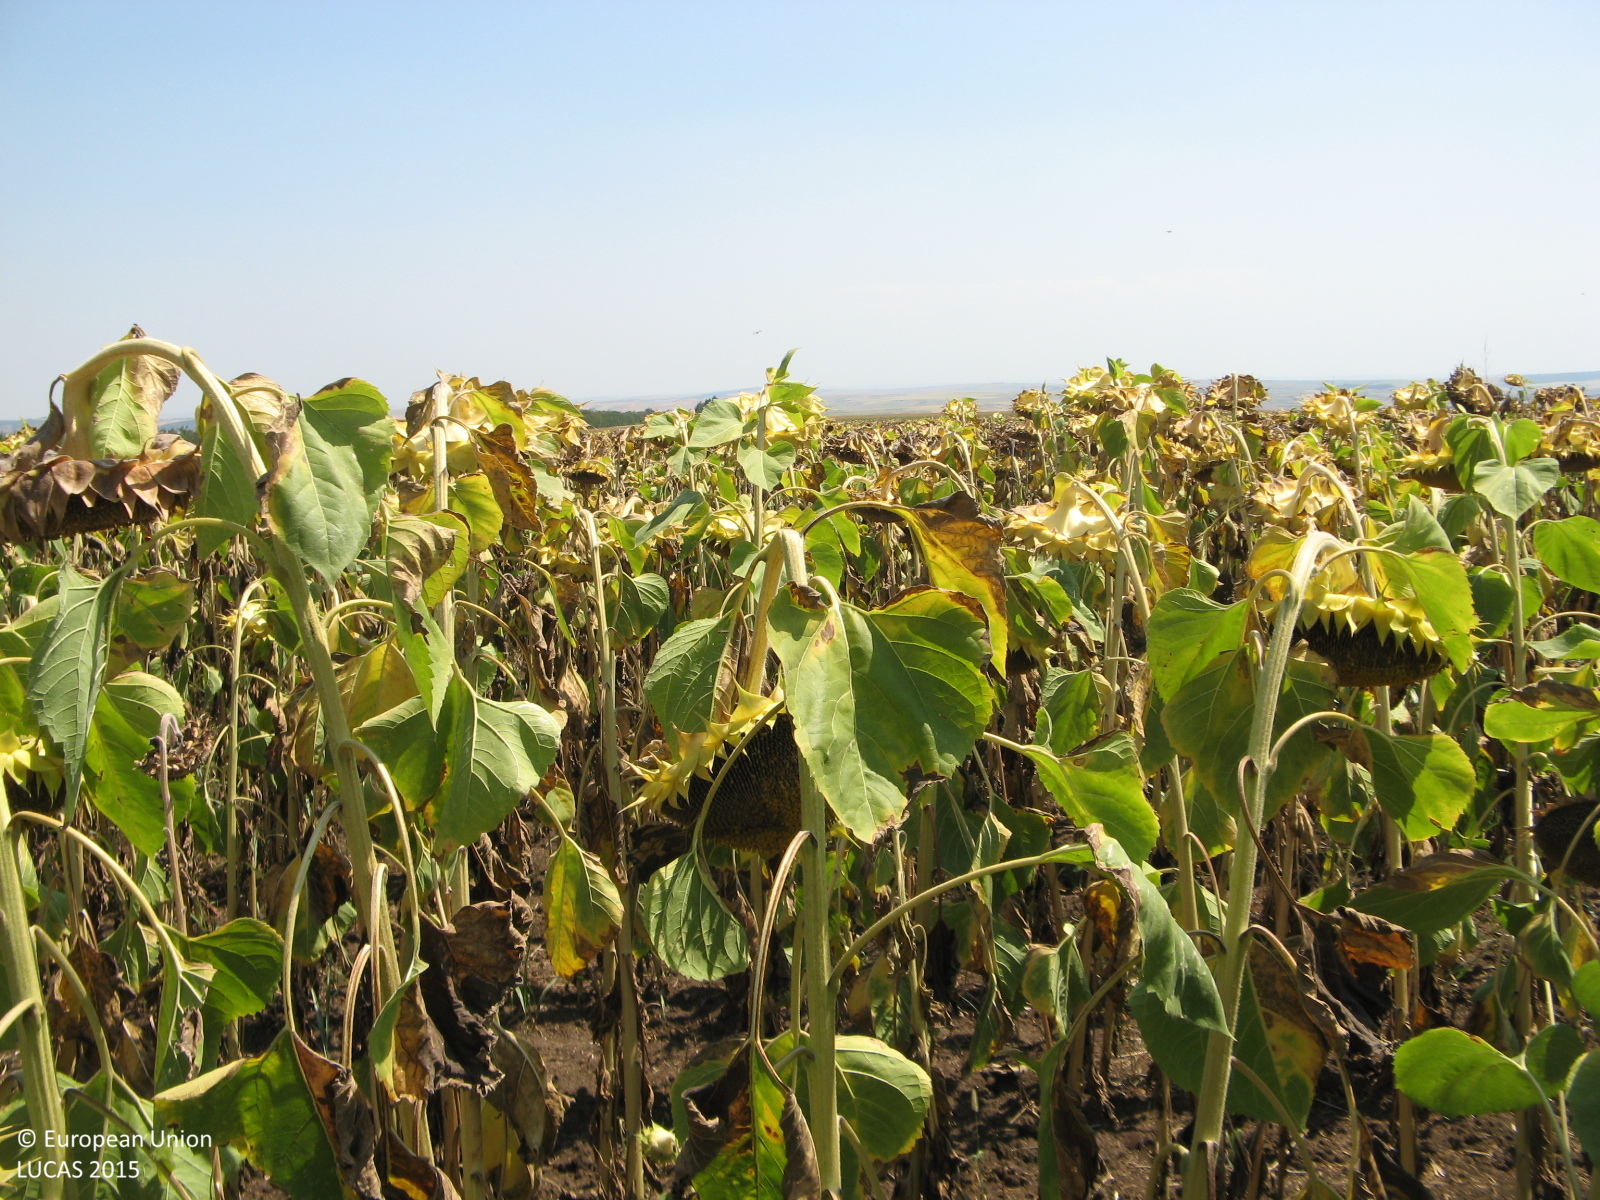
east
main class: Cropland
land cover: Sunflower
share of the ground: > 75 %
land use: Agriculture (excluding fallow land and kitchen gardens)
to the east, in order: Sunflower
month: August
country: BG
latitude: 43.3879
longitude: 25.3222
